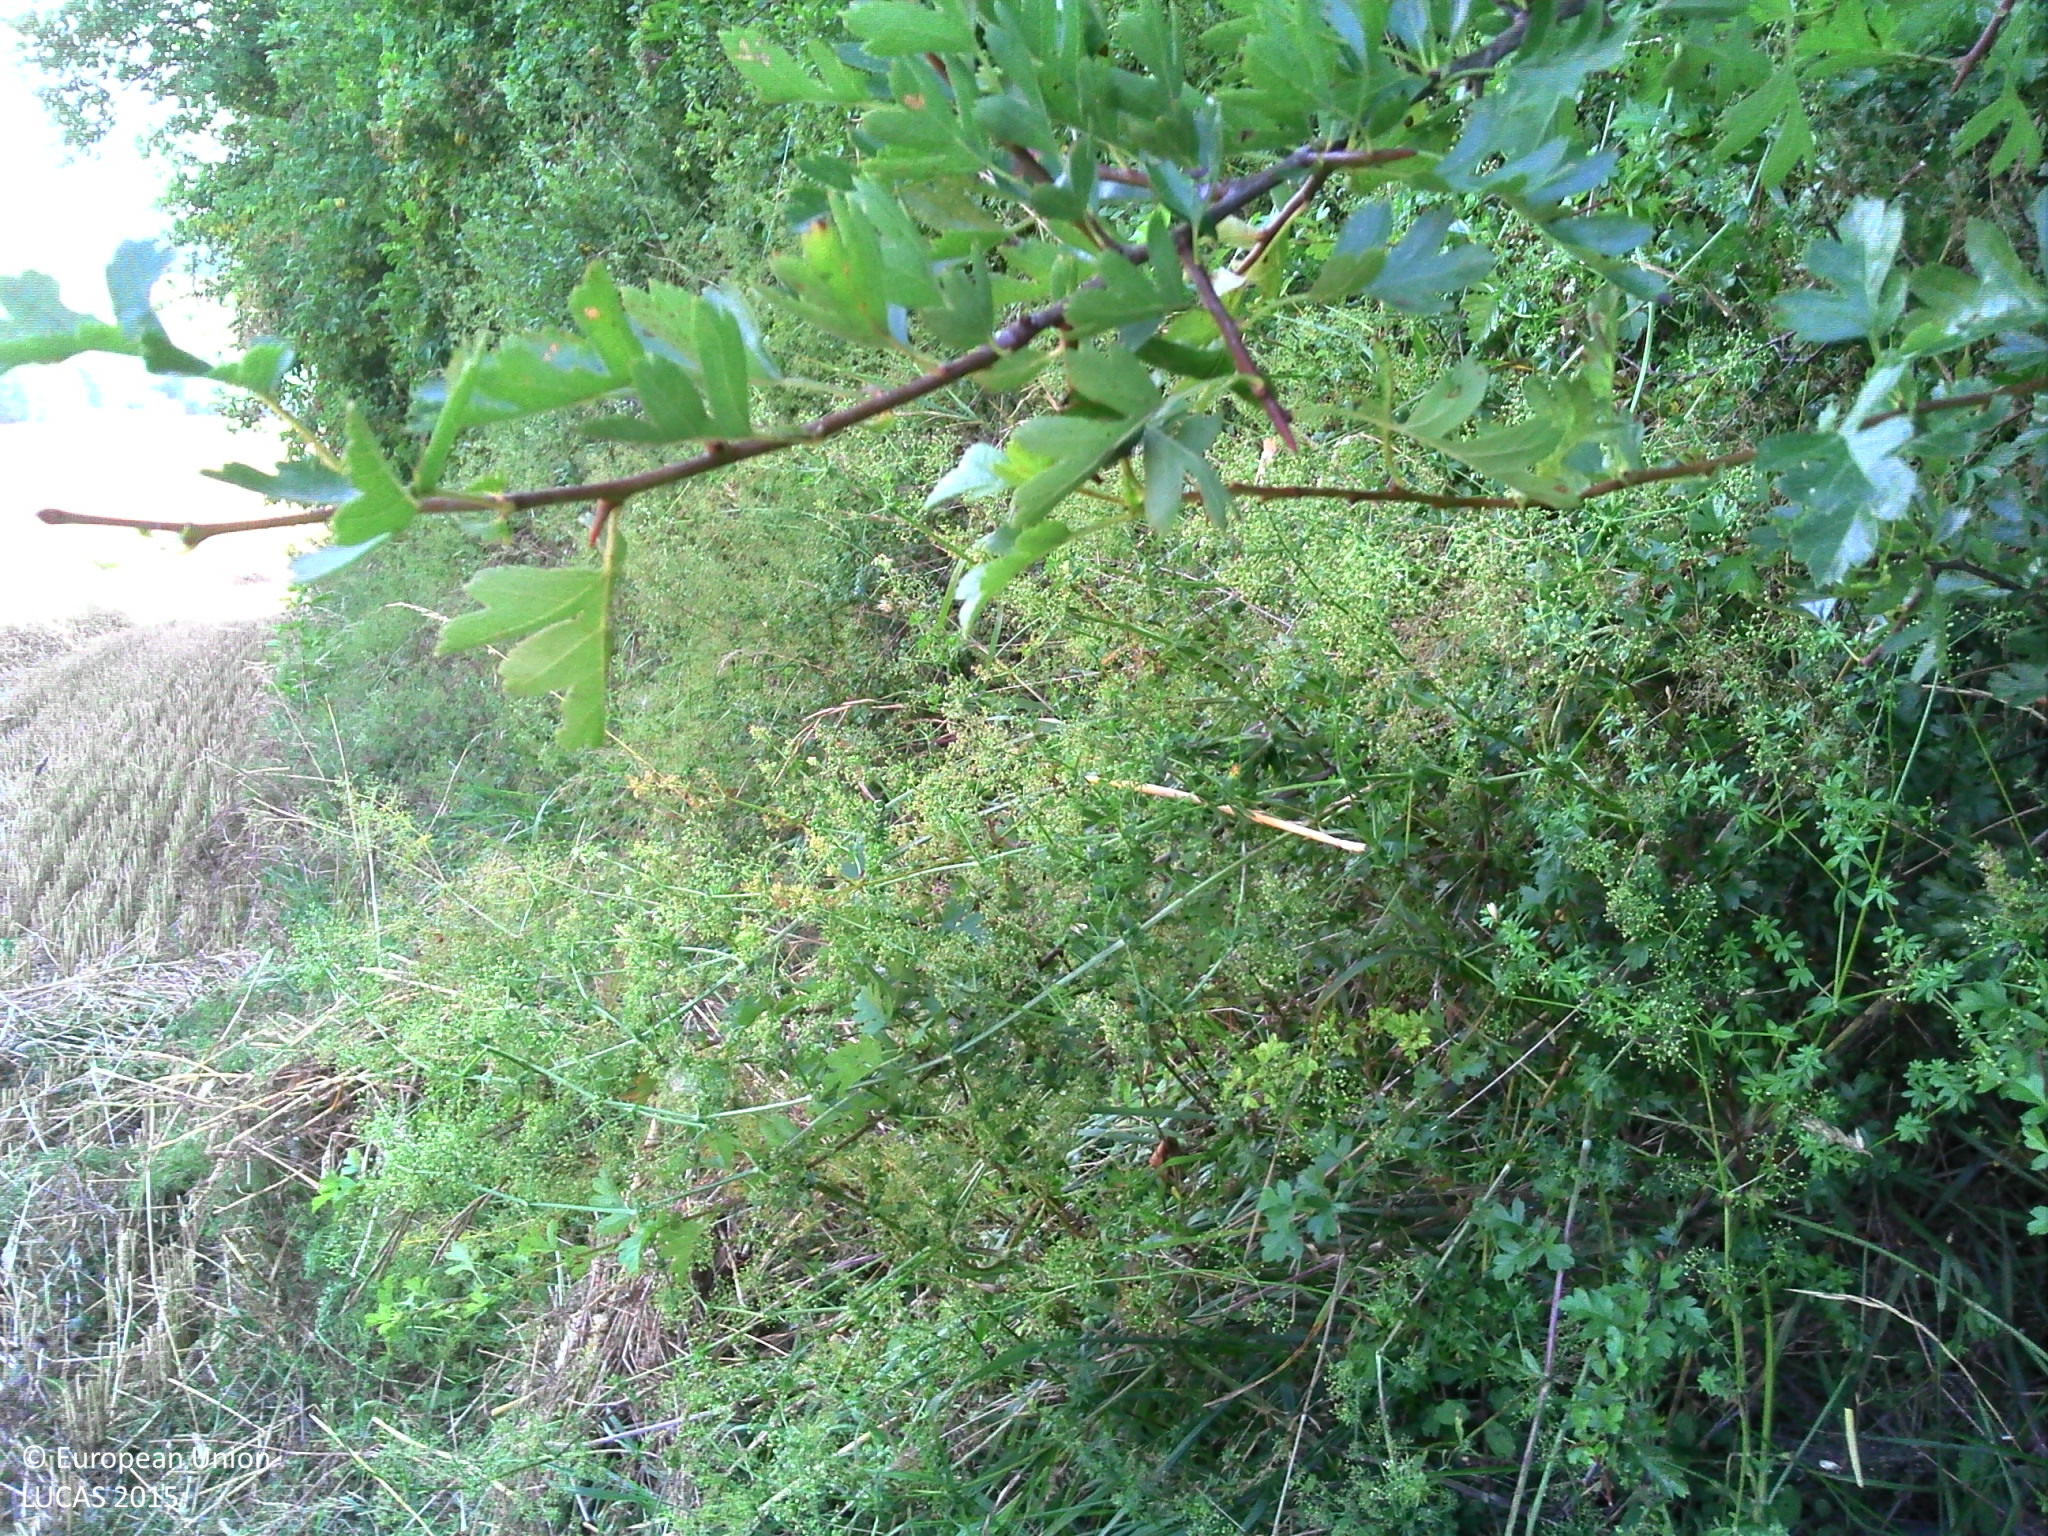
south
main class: Cropland
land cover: Common wheat
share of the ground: > 75 %
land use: Agriculture (excluding fallow land and kitchen gardens)
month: August
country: FR
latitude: 50.8080
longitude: 2.0231
